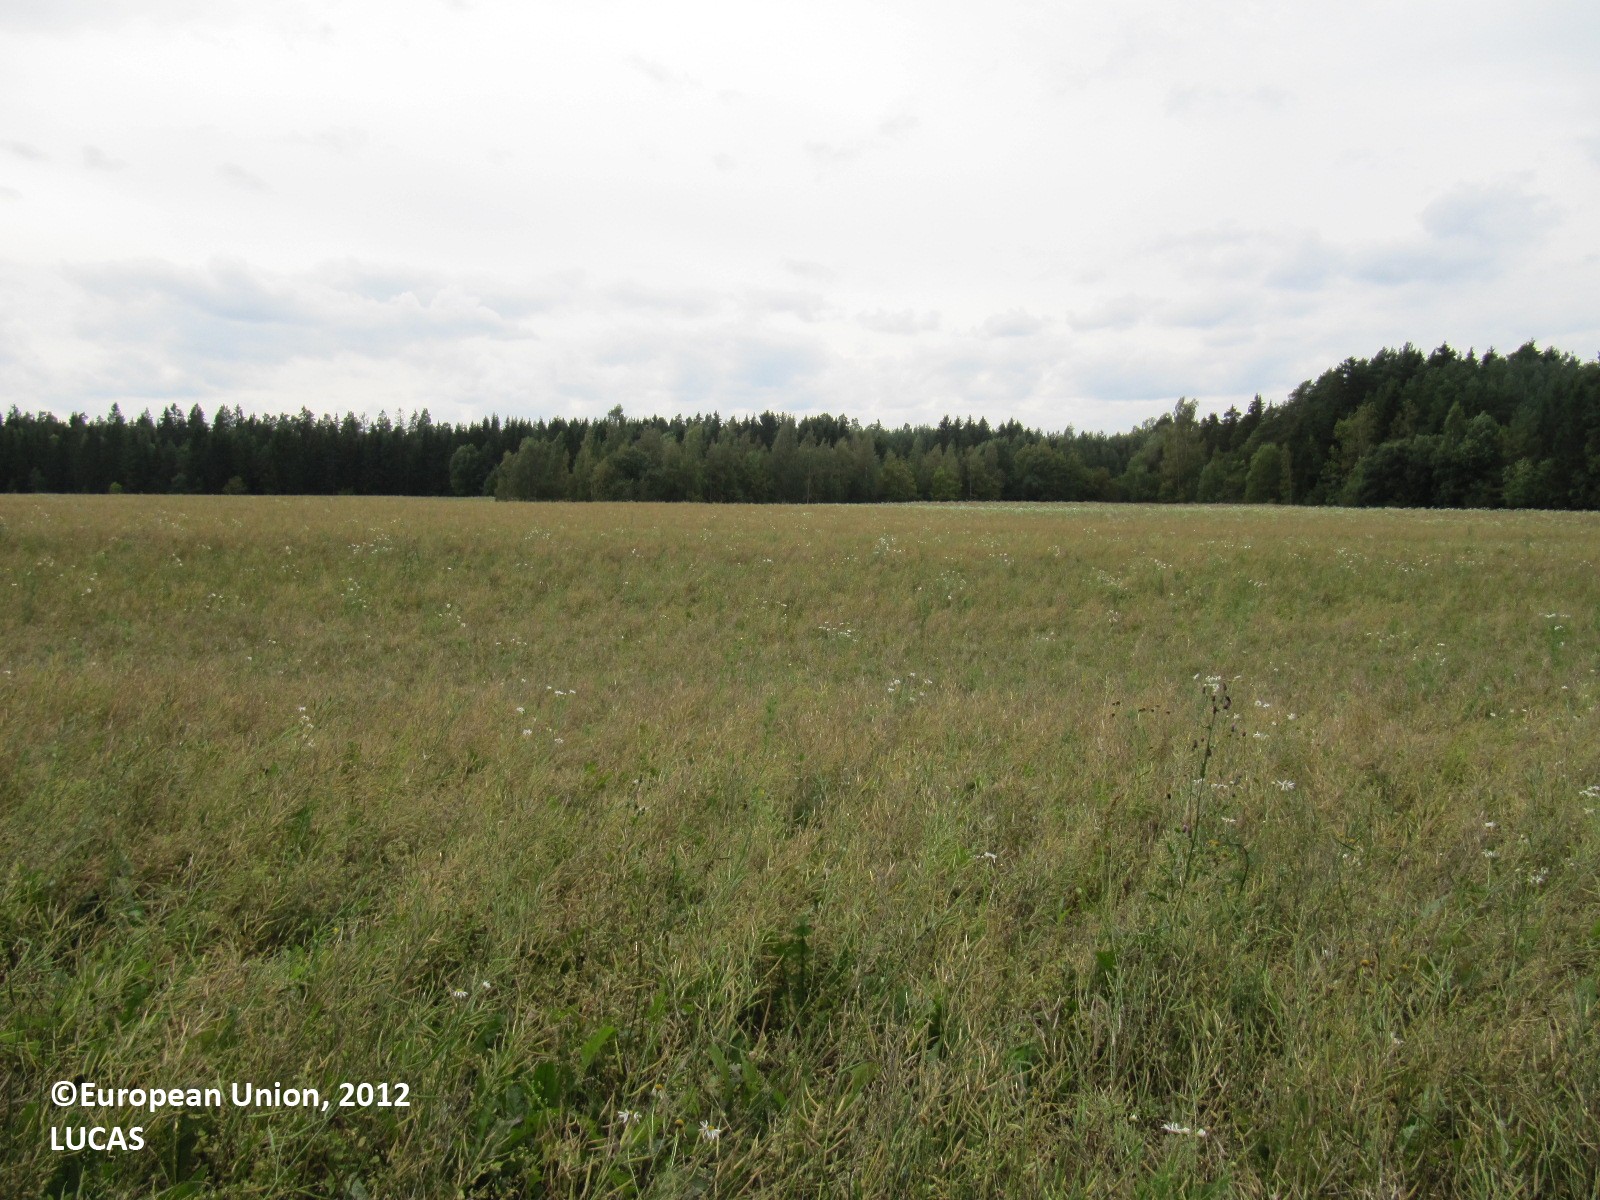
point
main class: Cropland
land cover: Rape and turnip rape
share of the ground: > 75 %
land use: Agriculture (excluding fallow land and kitchen gardens)
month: August
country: FI
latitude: 60.9381
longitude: 22.8997
